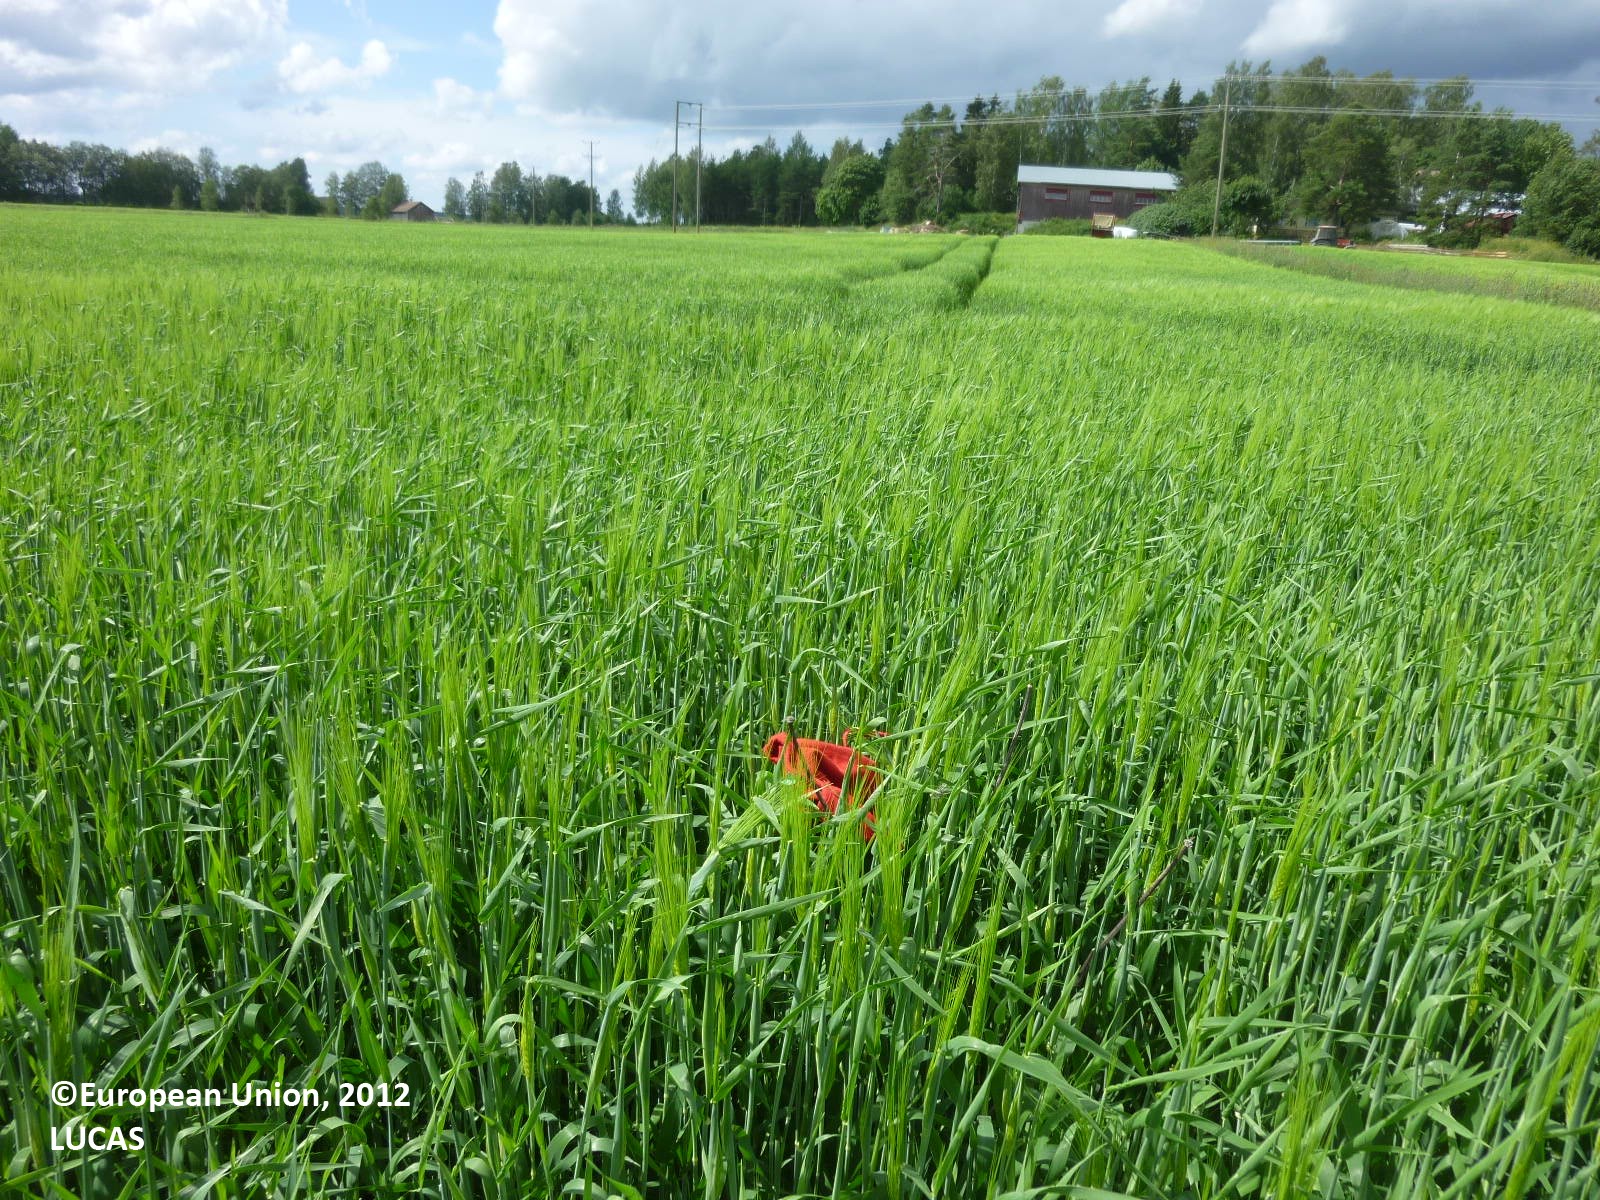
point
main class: Cropland
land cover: Barley
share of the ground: > 75 %
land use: Agriculture (excluding fallow land and kitchen gardens)
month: July
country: FI
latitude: 61.2239
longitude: 21.9196
